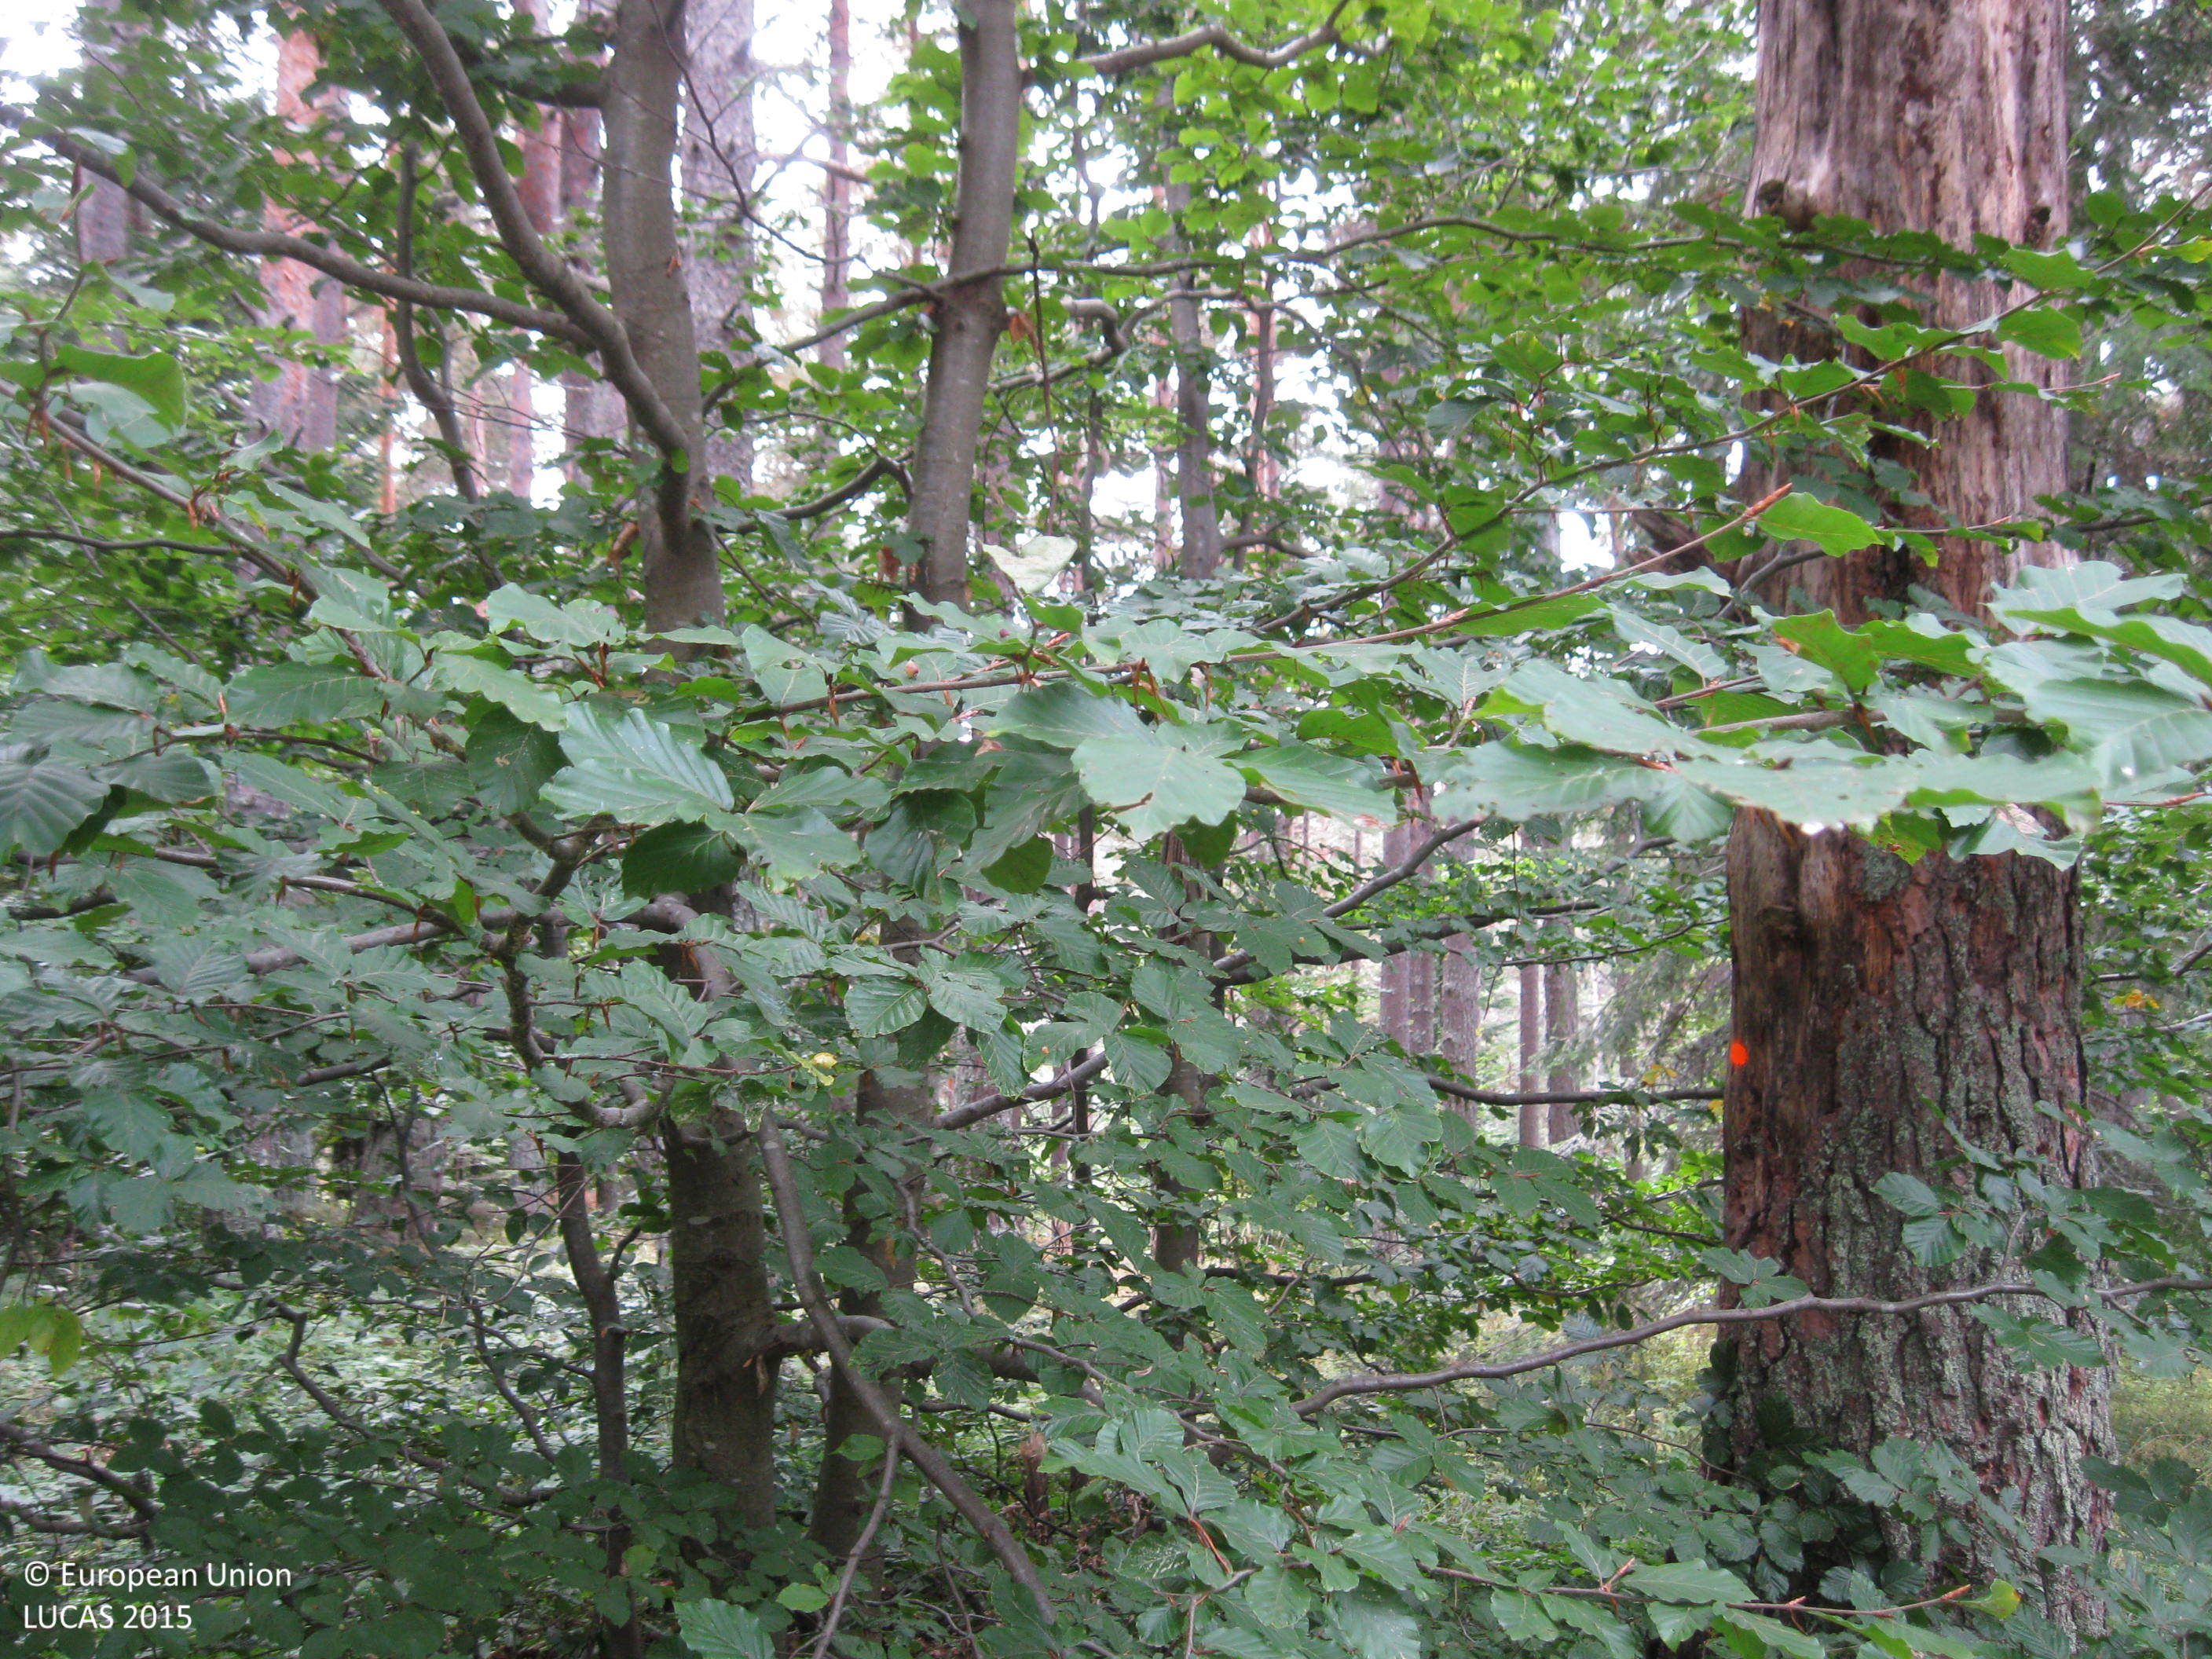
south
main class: Woodland
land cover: Pine dominated coniferous woodland
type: alpine coniferous forest
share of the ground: > 75 %
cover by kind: coniferous forest trees 80 %, herbaceous plants 10 %, broadleaved forest trees 5 %, shrubs 5 %
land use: Amenities, museums, leisure
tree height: > 5 m
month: October
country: BG
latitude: 41.9653
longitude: 24.5372
